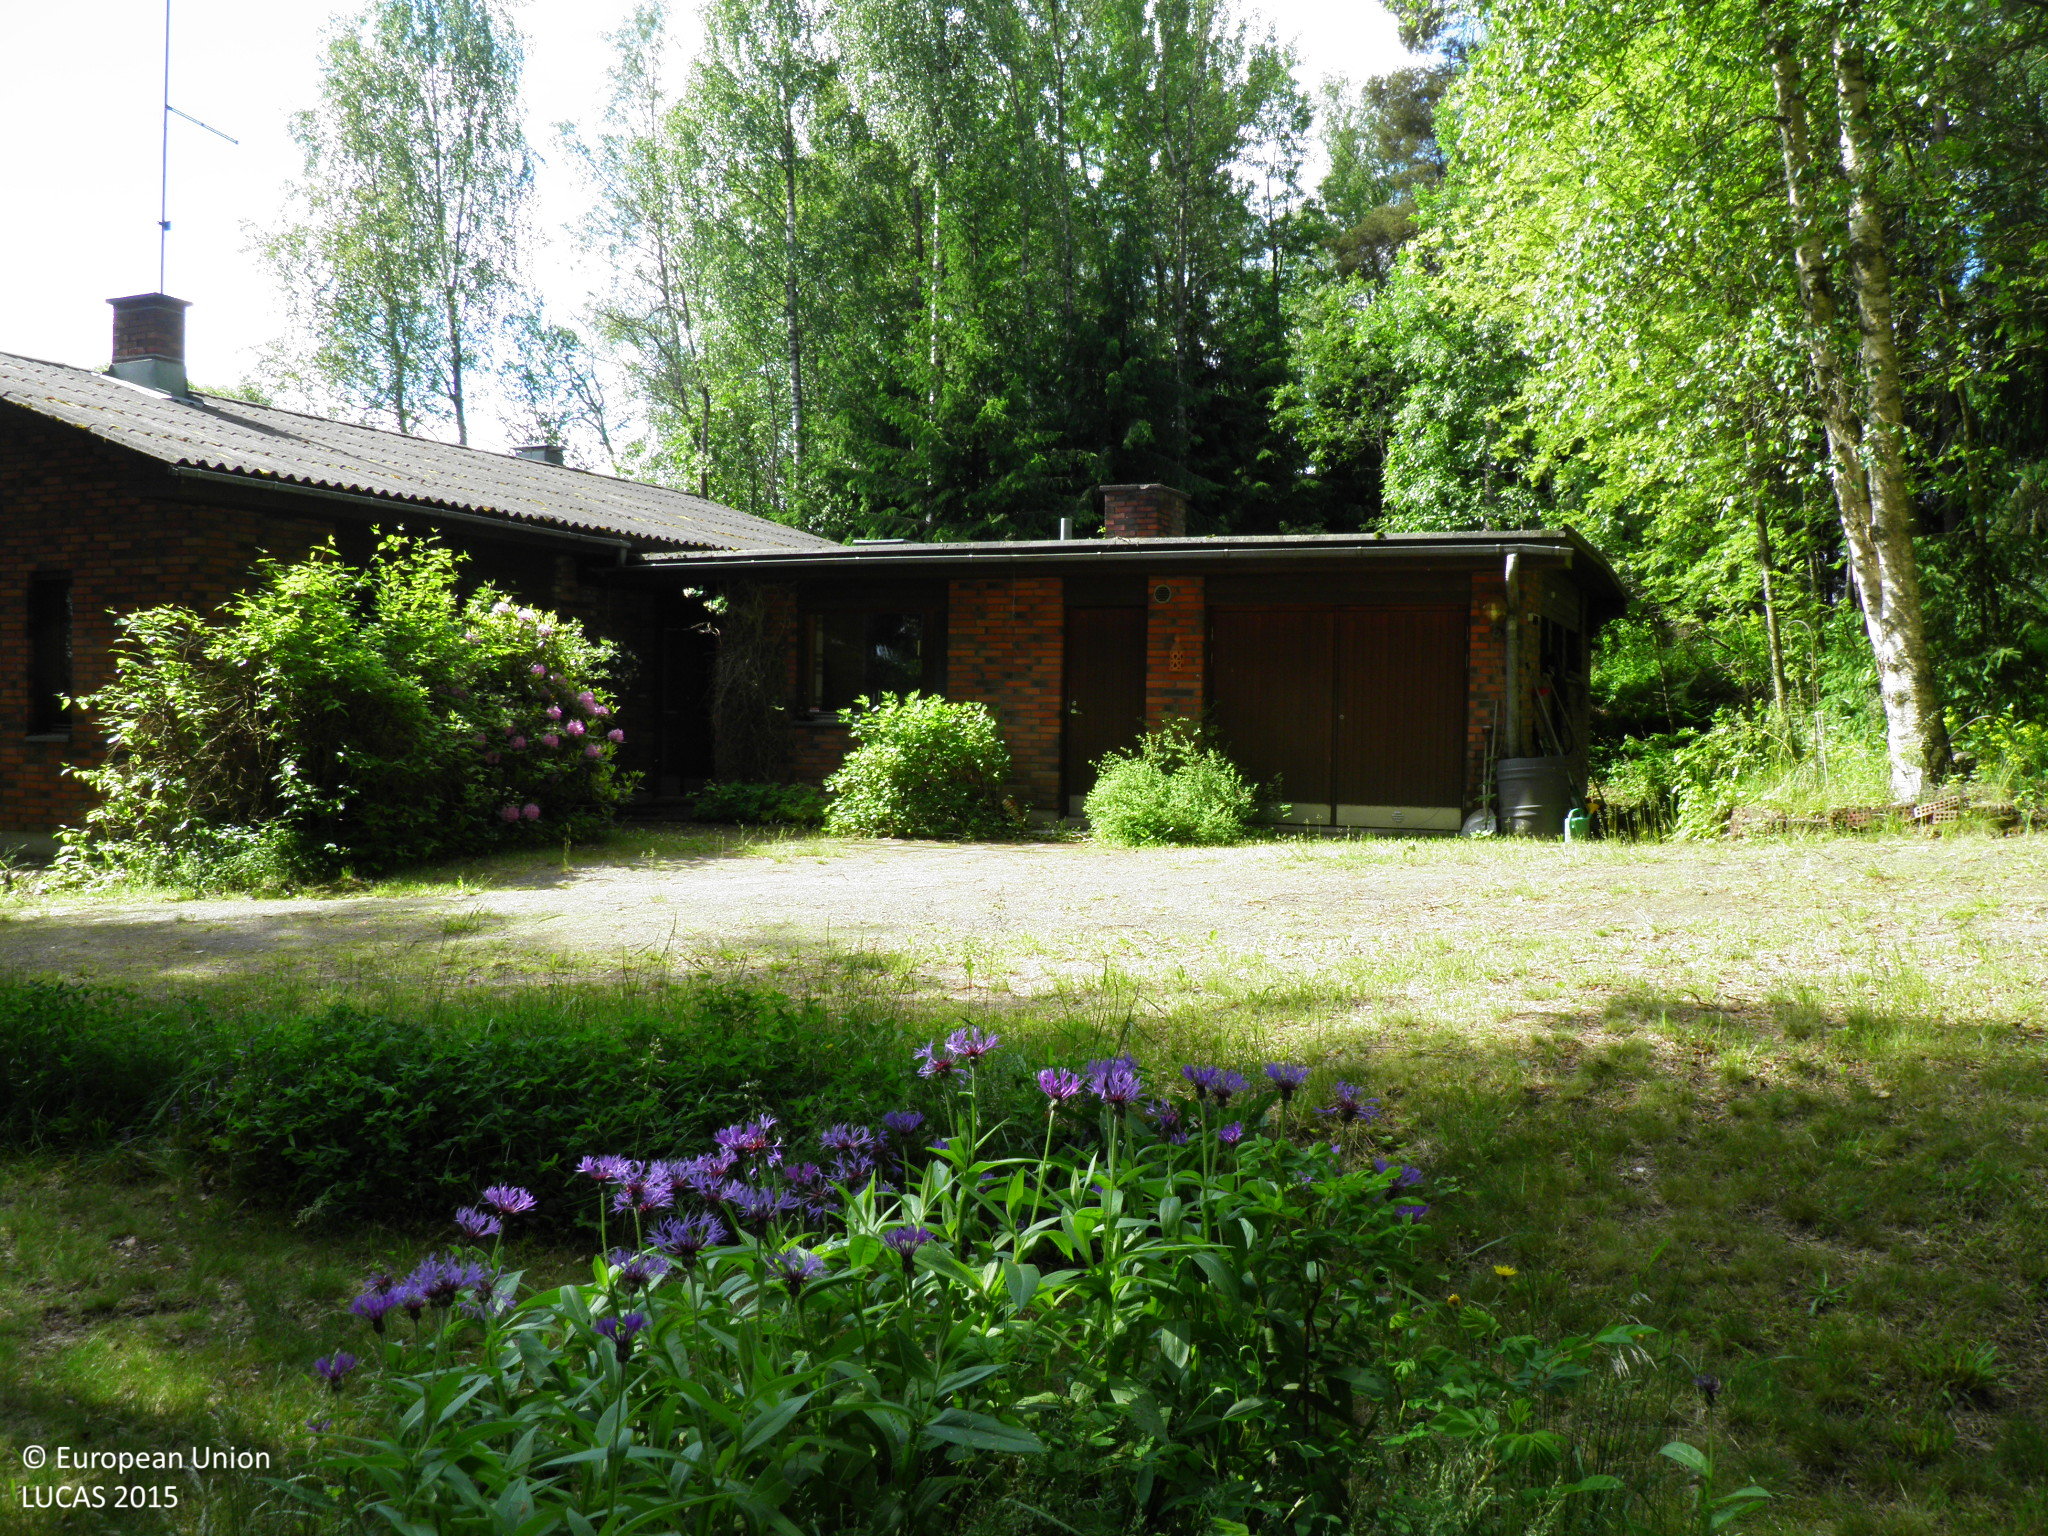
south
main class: Grassland
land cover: Grassland without tree/shrub cover
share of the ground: > 75 %
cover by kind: herbaceous plants 95 %, shrubs 5 %
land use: Residential
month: June
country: FI
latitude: 60.3233
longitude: 22.6214
